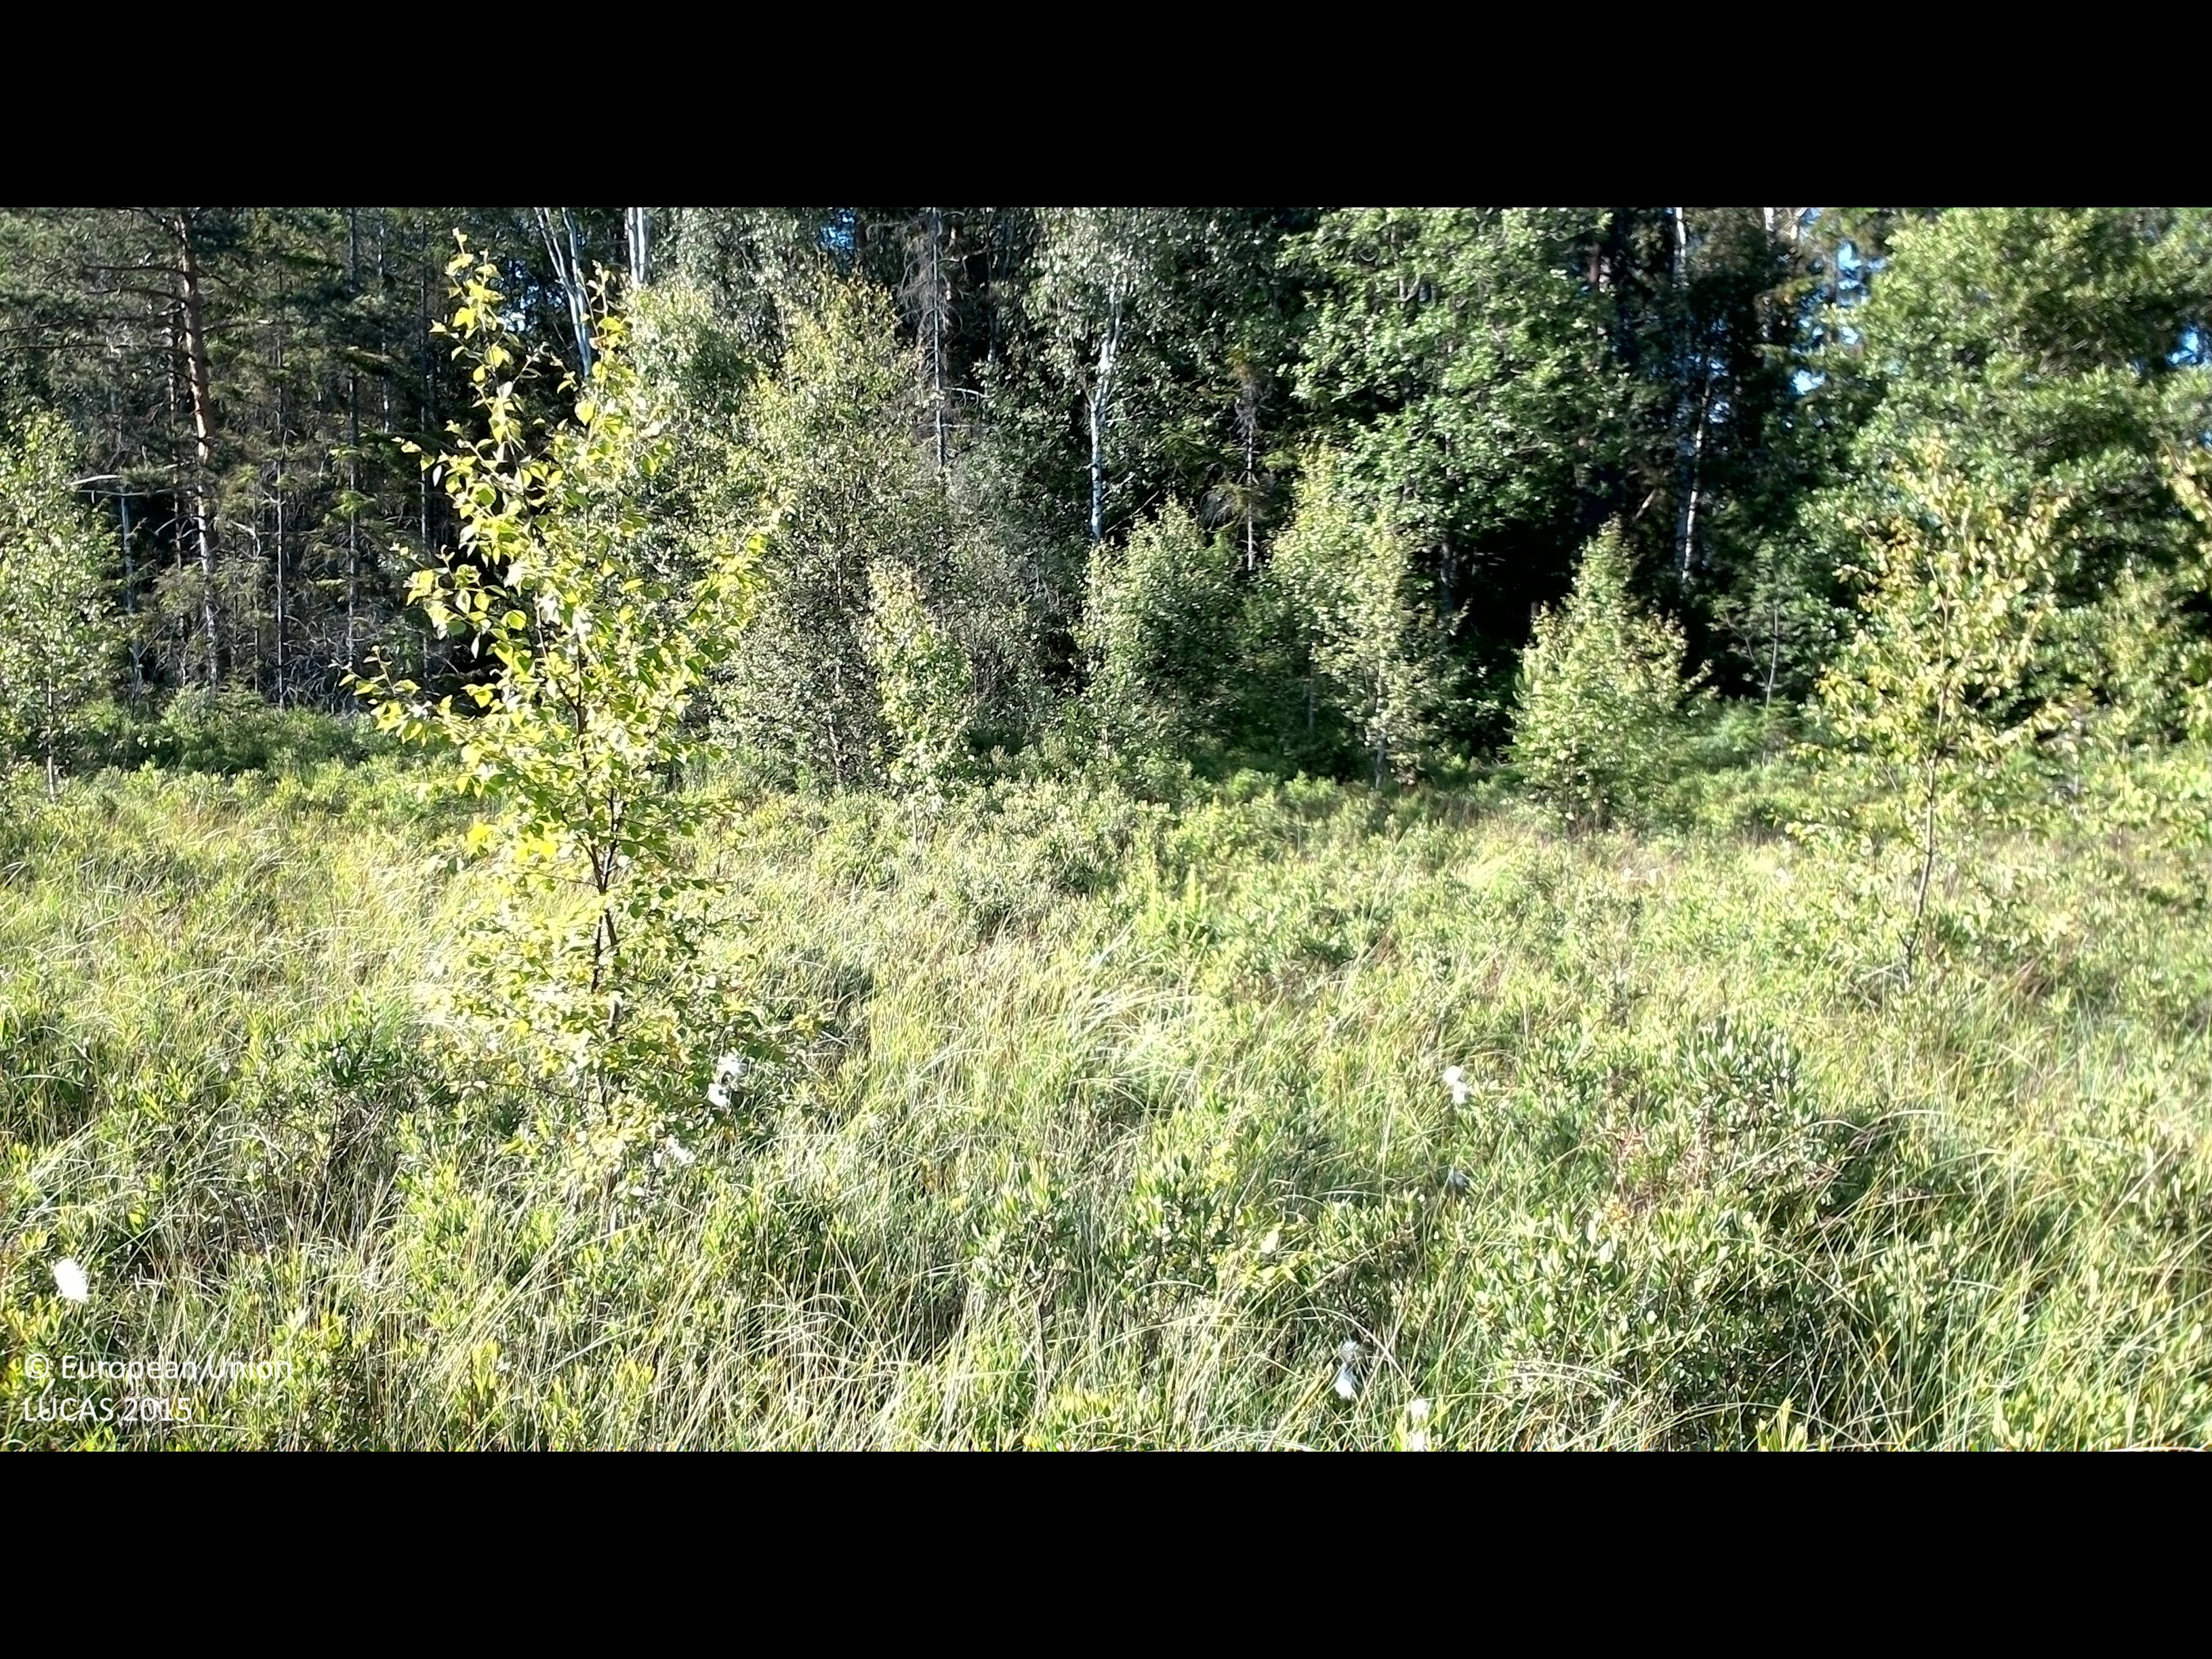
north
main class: Shrubland
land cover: Shrubland with sparse tree cover
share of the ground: > 75 %
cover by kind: shrubs 85 %, broadleaved forest trees 5 %, herbaceous plants 5 %, lichens and mosses 5 %
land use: Semi-natural and natural areas not in use
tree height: < 5 m
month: July
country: SE
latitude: 56.4631
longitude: 15.1432
